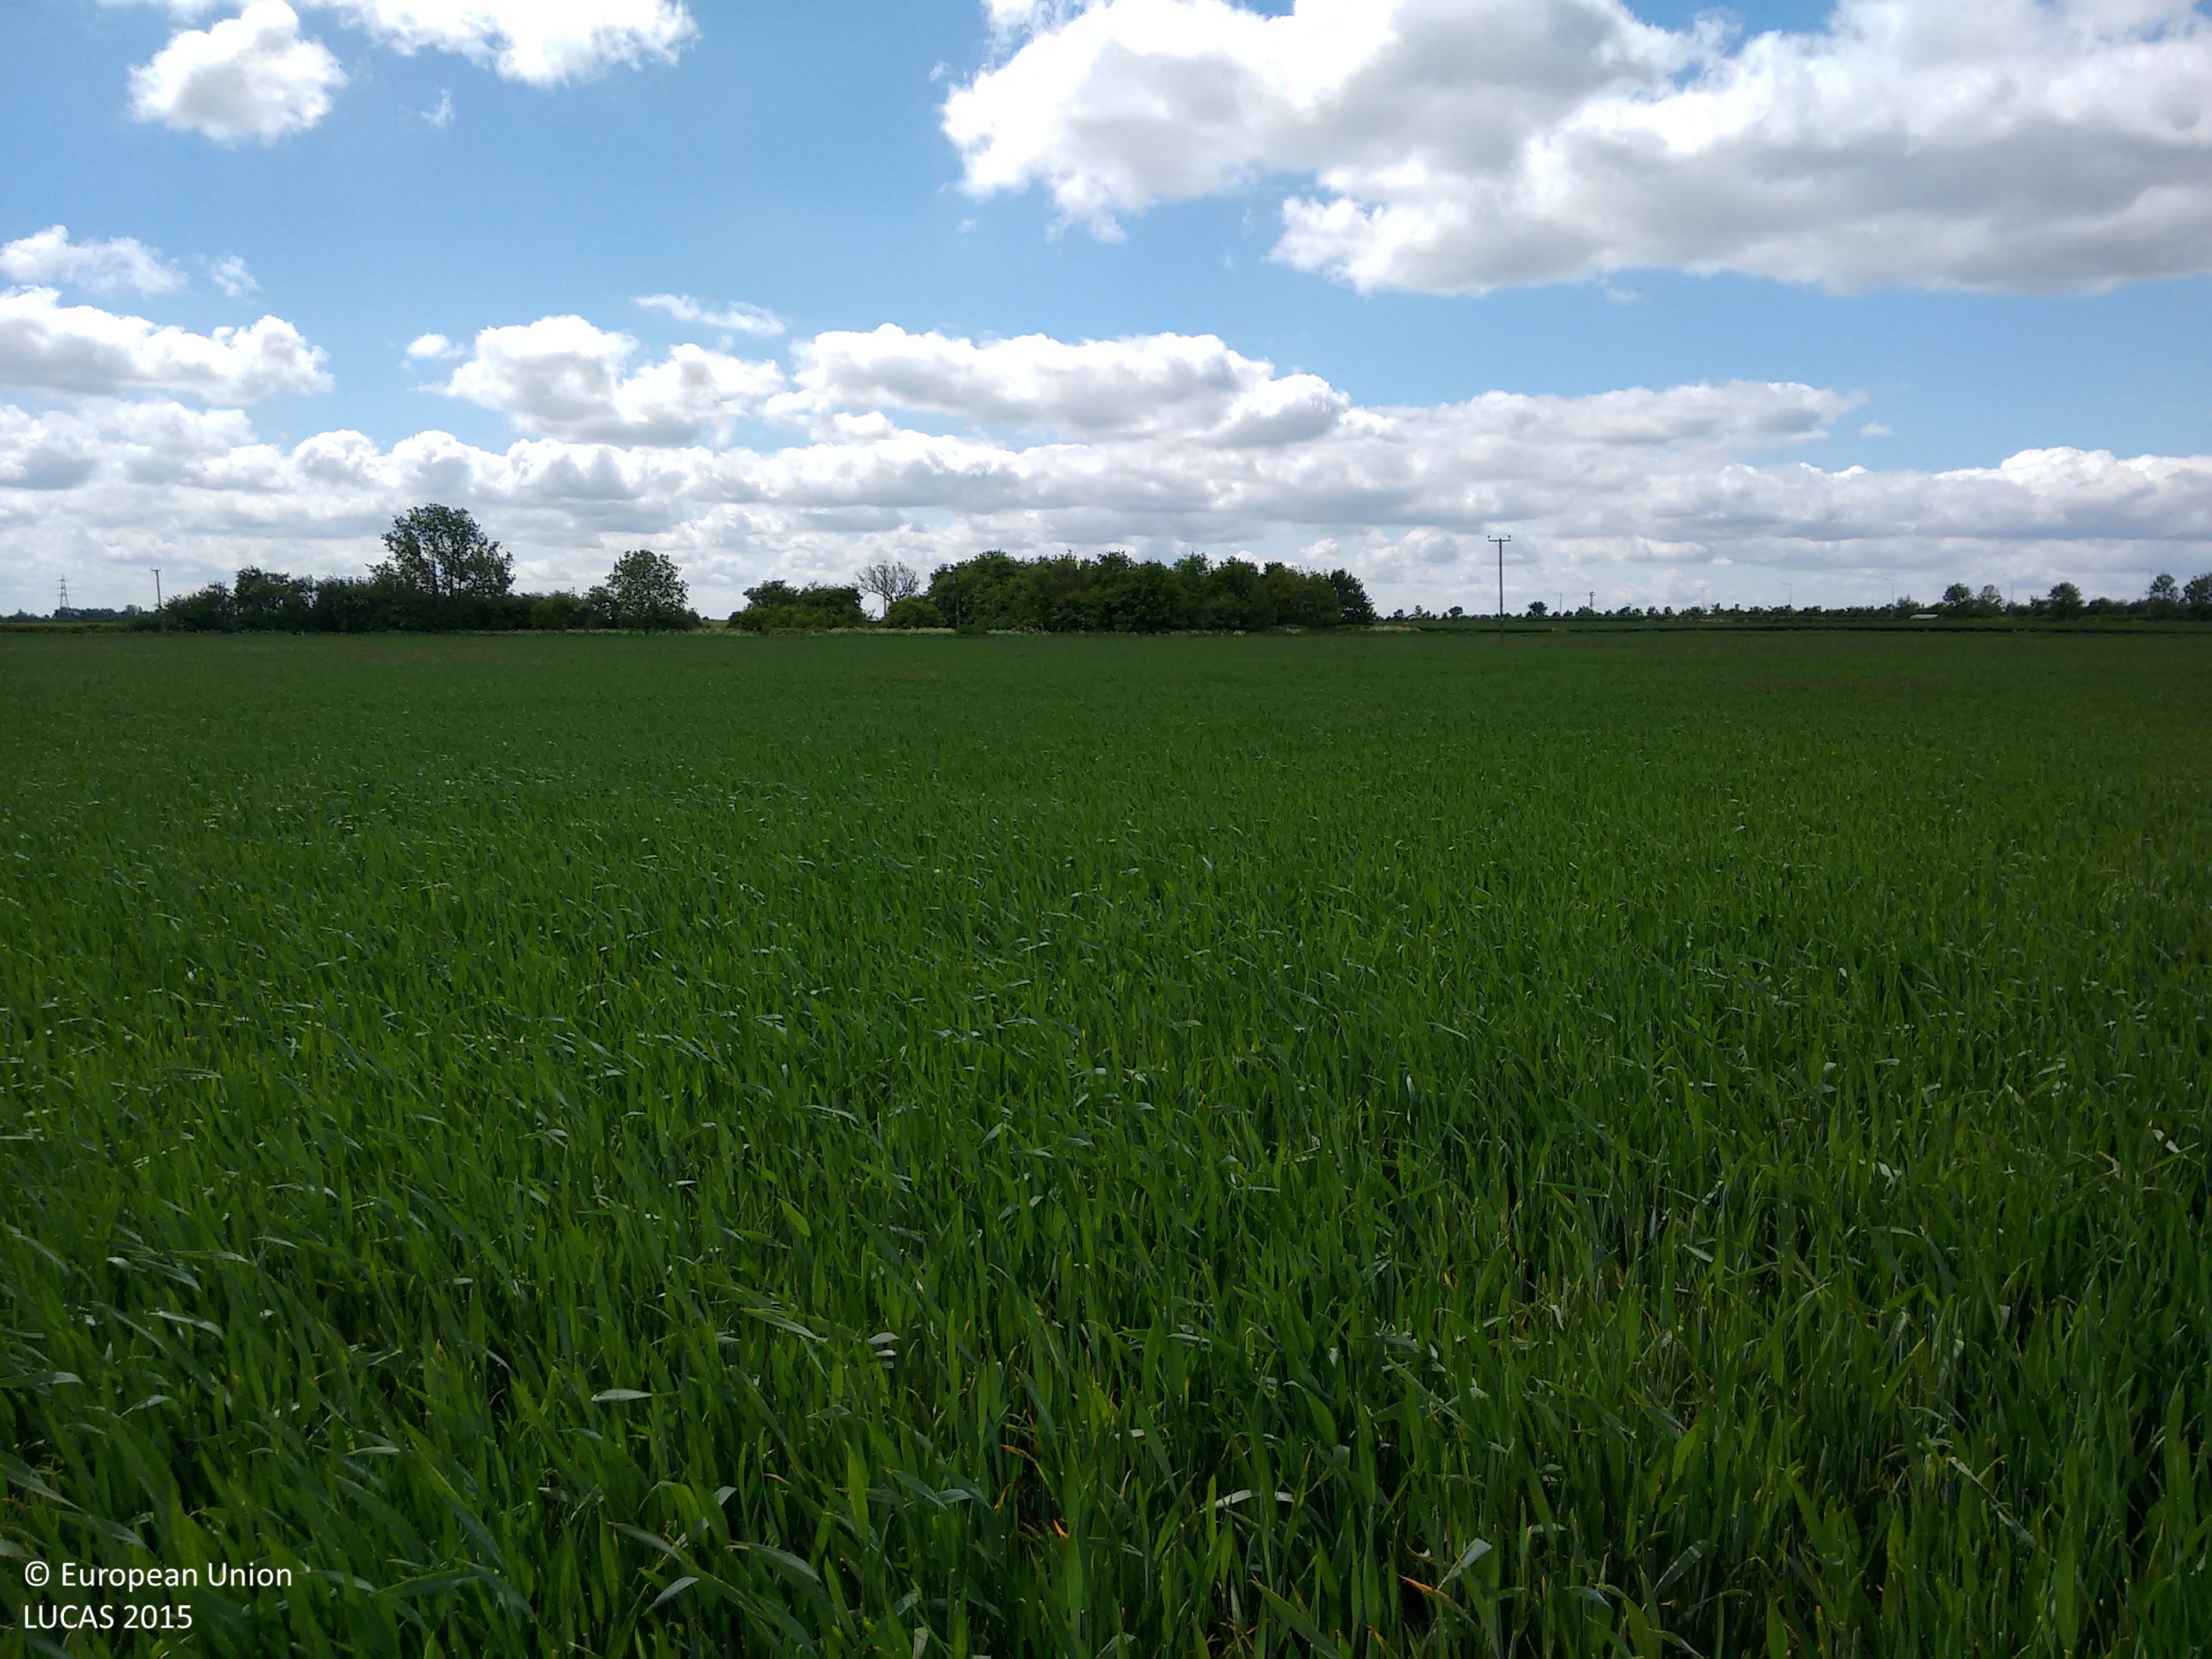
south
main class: Cropland
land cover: Common wheat
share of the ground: > 75 %
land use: Agriculture (excluding fallow land and kitchen gardens)
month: June
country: GB
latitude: 53.5431
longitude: -0.0677
